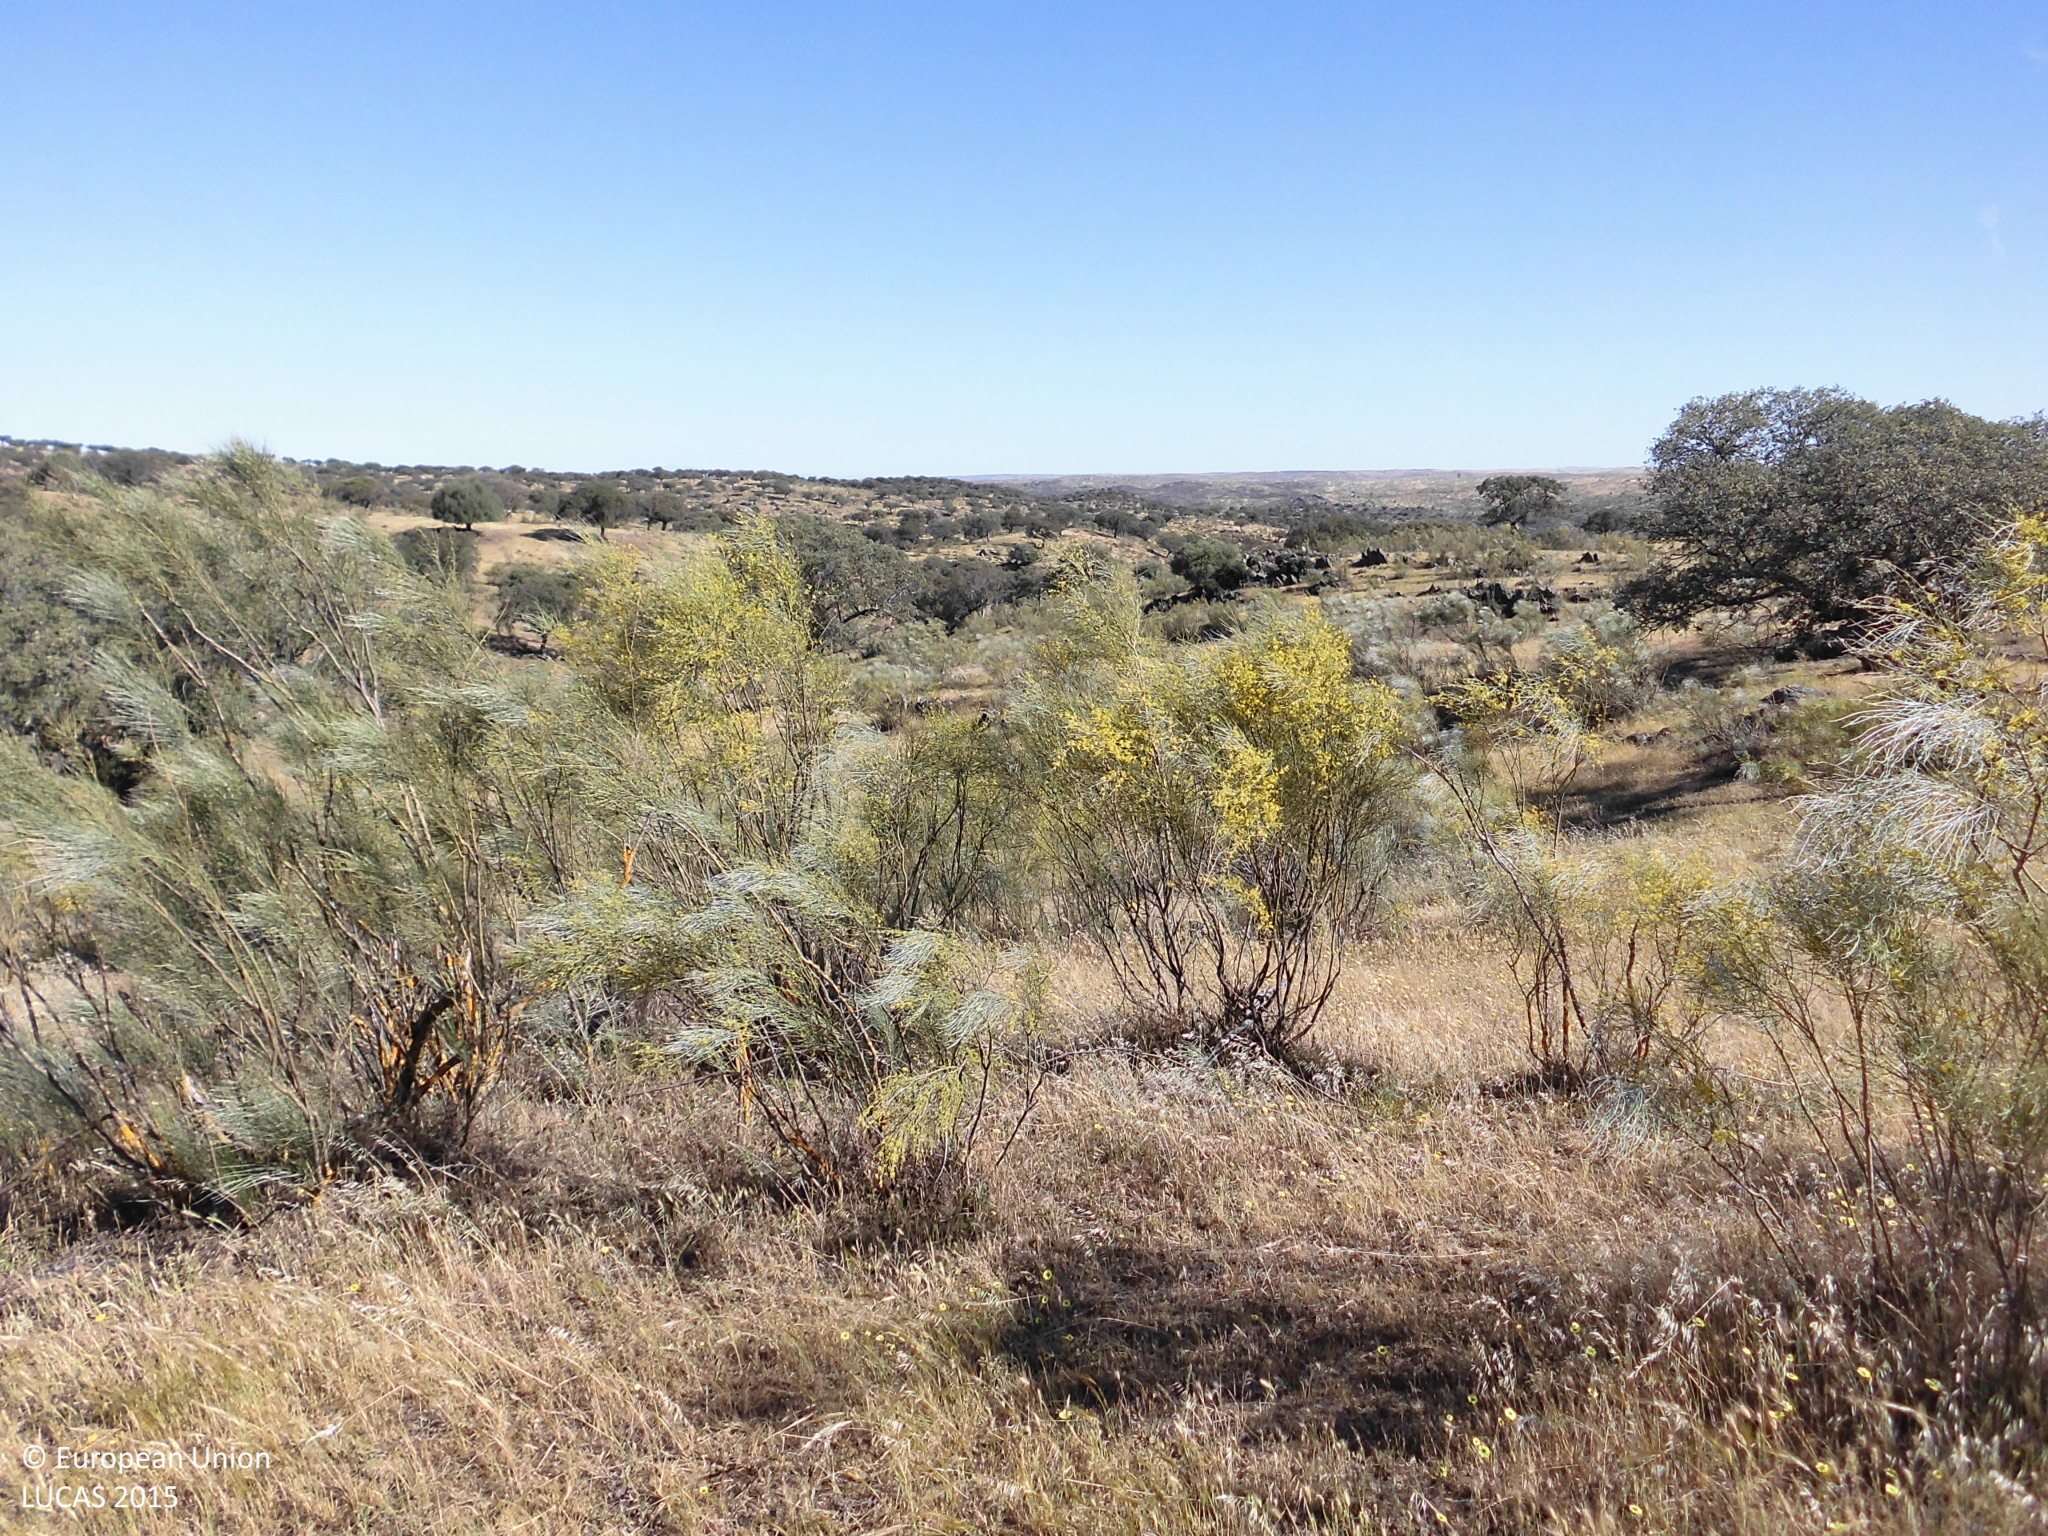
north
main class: Woodland
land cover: Broadleaved woodland
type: broadleaved evergreen forest
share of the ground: 10 - 25 %
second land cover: Grassland without tree/shrub cover
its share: > 75 %
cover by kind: herbaceous plants 65 %, broadleaved forest trees 25 %, shrubs 10 %
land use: Forestry
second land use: Agriculture (excluding fallow land and kitchen gardens)
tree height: > 5 m
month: May
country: ES
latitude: 39.5164
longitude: -6.9587
